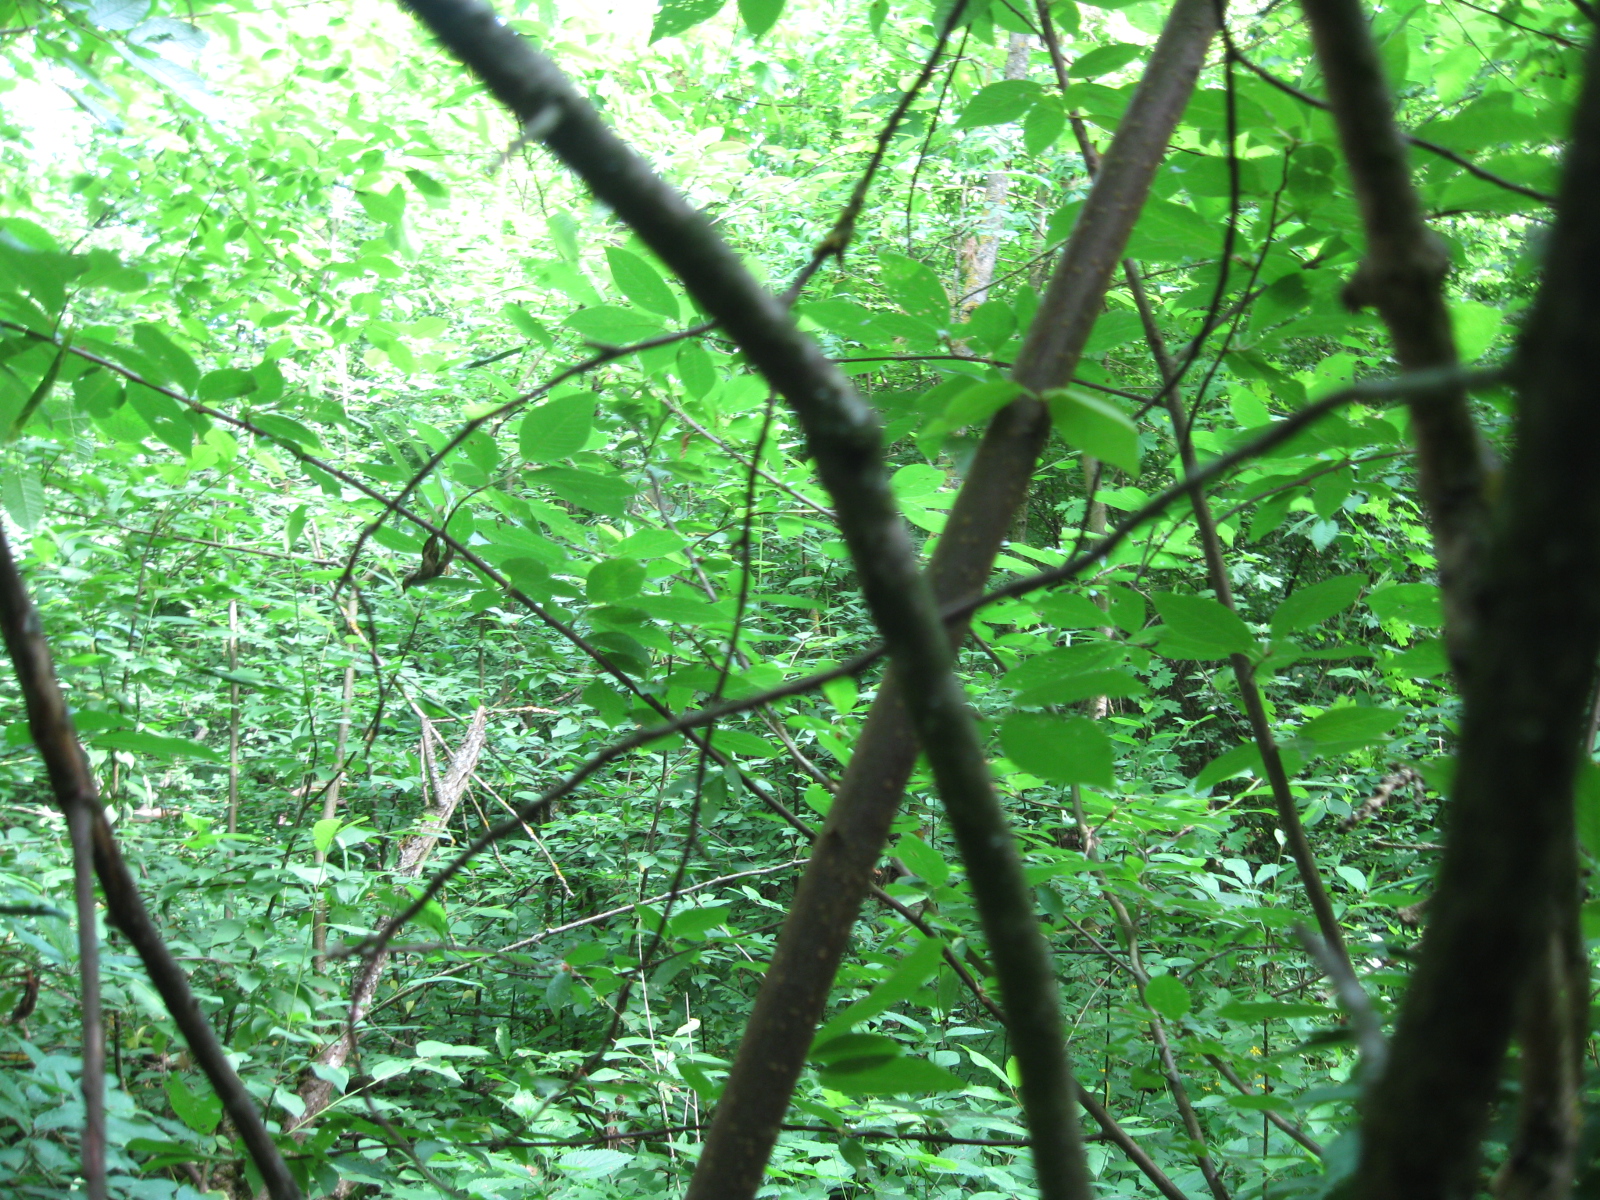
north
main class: Woodland
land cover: Pine dominated mixed woodland
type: hemiboreal forest and nemoral coniferous forest and mixed broadleaved-coniferous forest
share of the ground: > 75 %
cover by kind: broadleaved forest trees 45 %, coniferous forest trees 40 %, herbaceous plants 10 %, shrubs 5 %
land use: Forestry
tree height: > 5 m
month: June
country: LT
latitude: 55.7443
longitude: 23.8320
